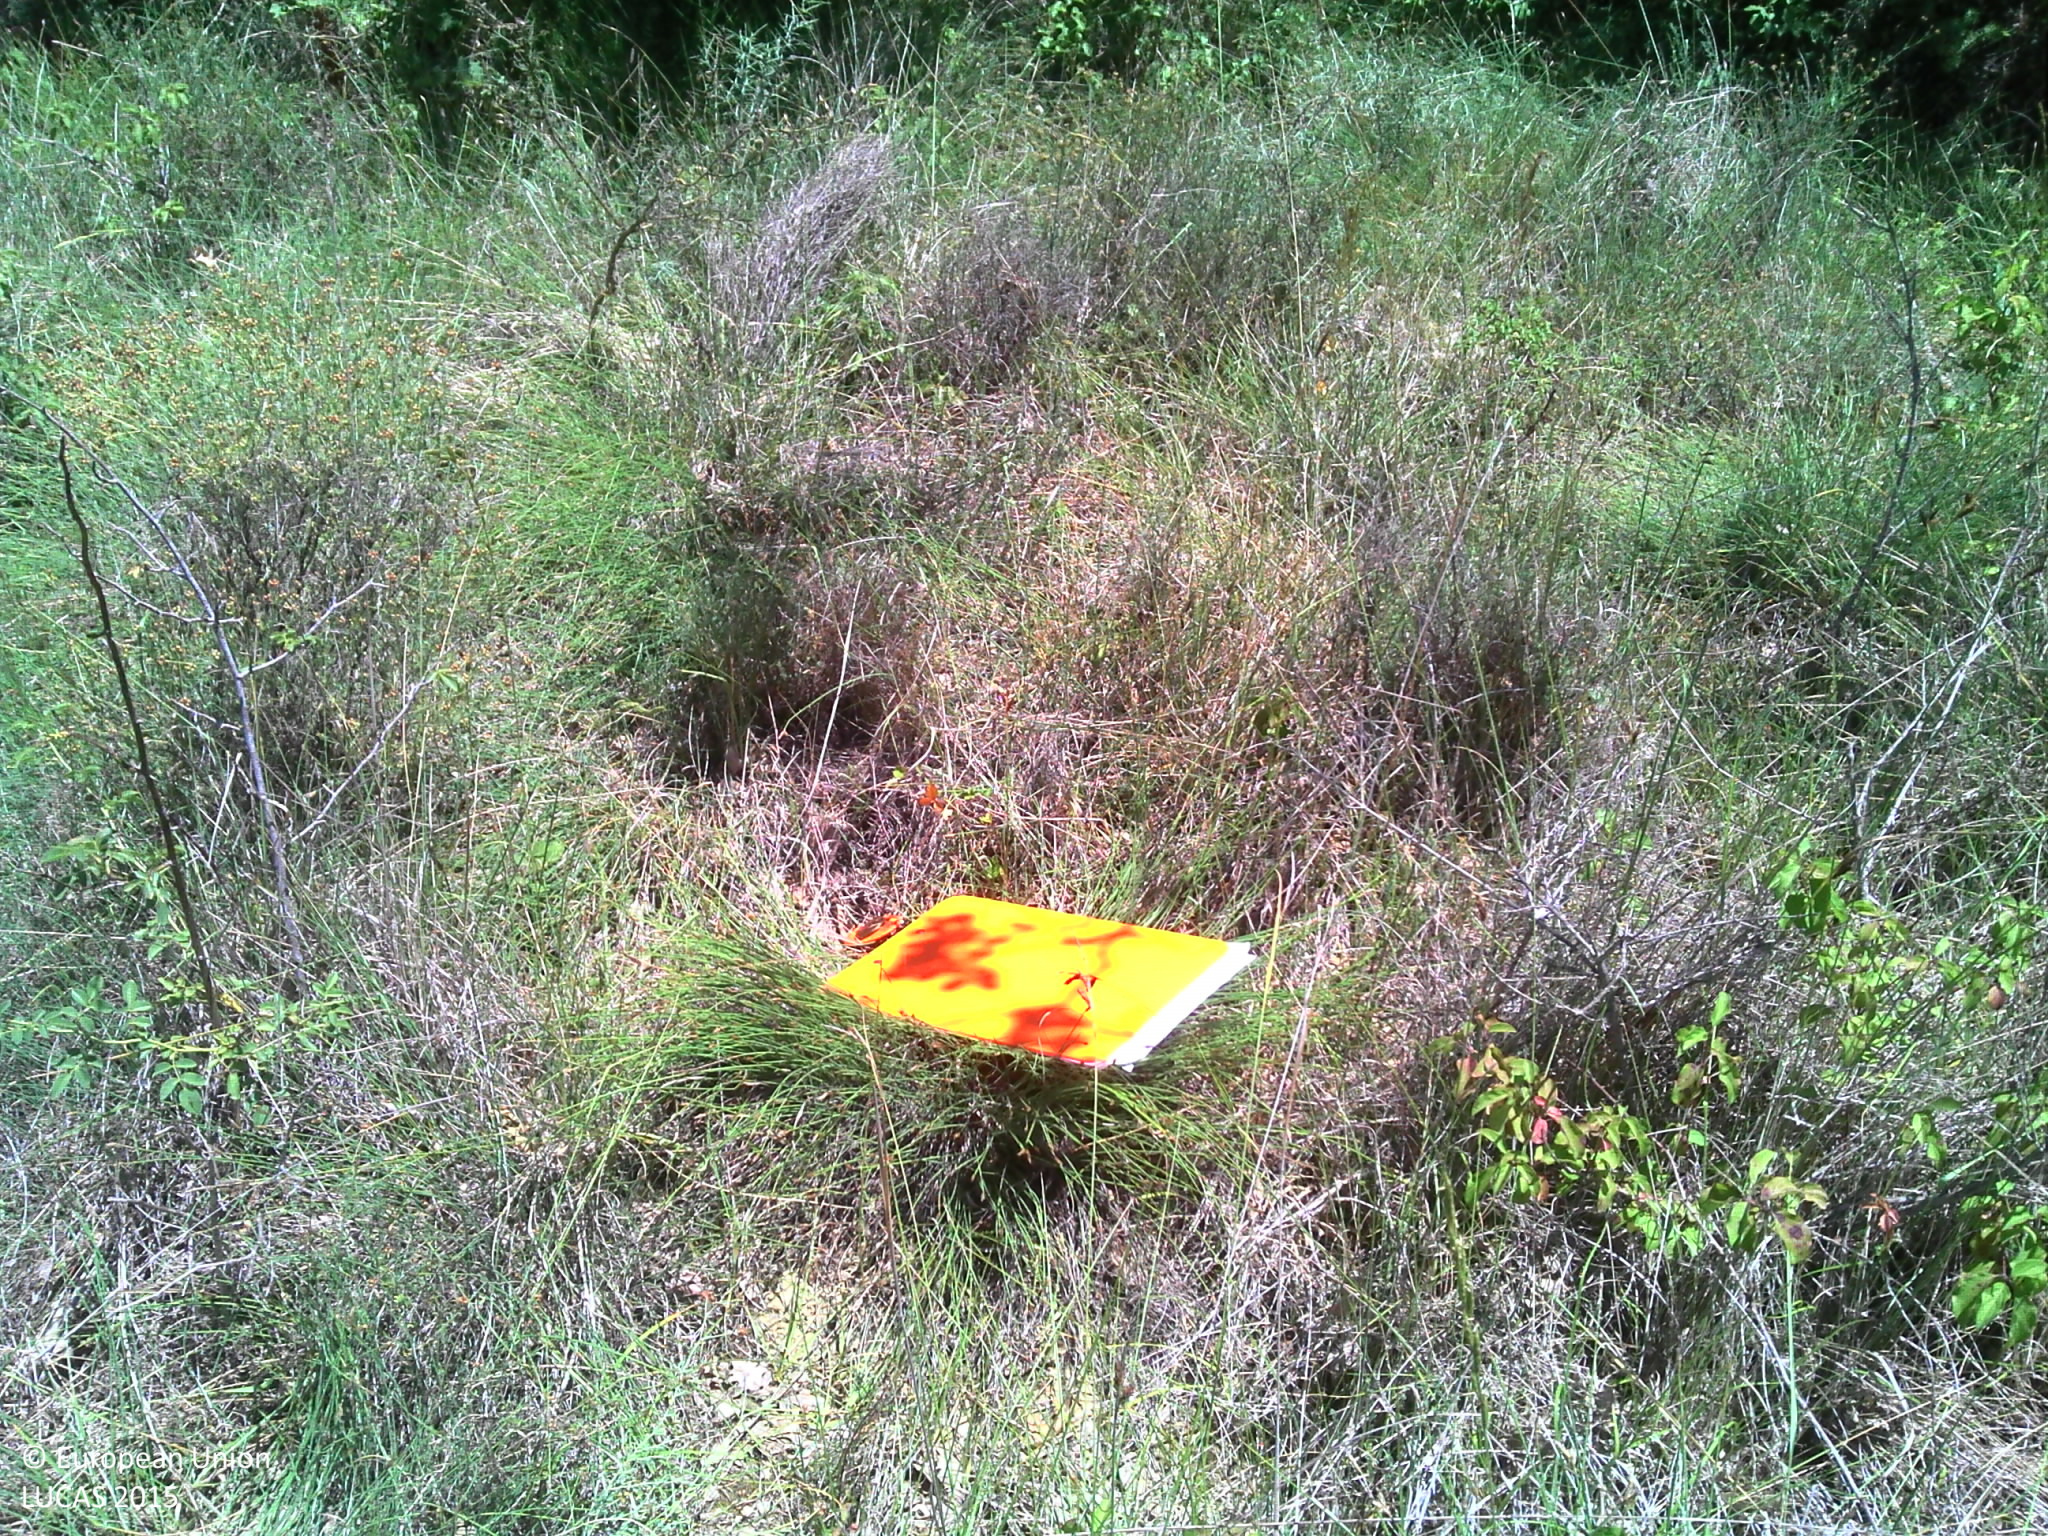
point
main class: Woodland
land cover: Other mixed woodland
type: thermophilous deciduous forest
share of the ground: 50 - 75 %
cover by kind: coniferous forest trees 35 %, broadleaved forest trees 35 %, herbaceous plants 30 %
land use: Semi-natural and natural areas not in use
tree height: < 5 m
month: July
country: FR
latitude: 42.9835
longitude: 2.1478
